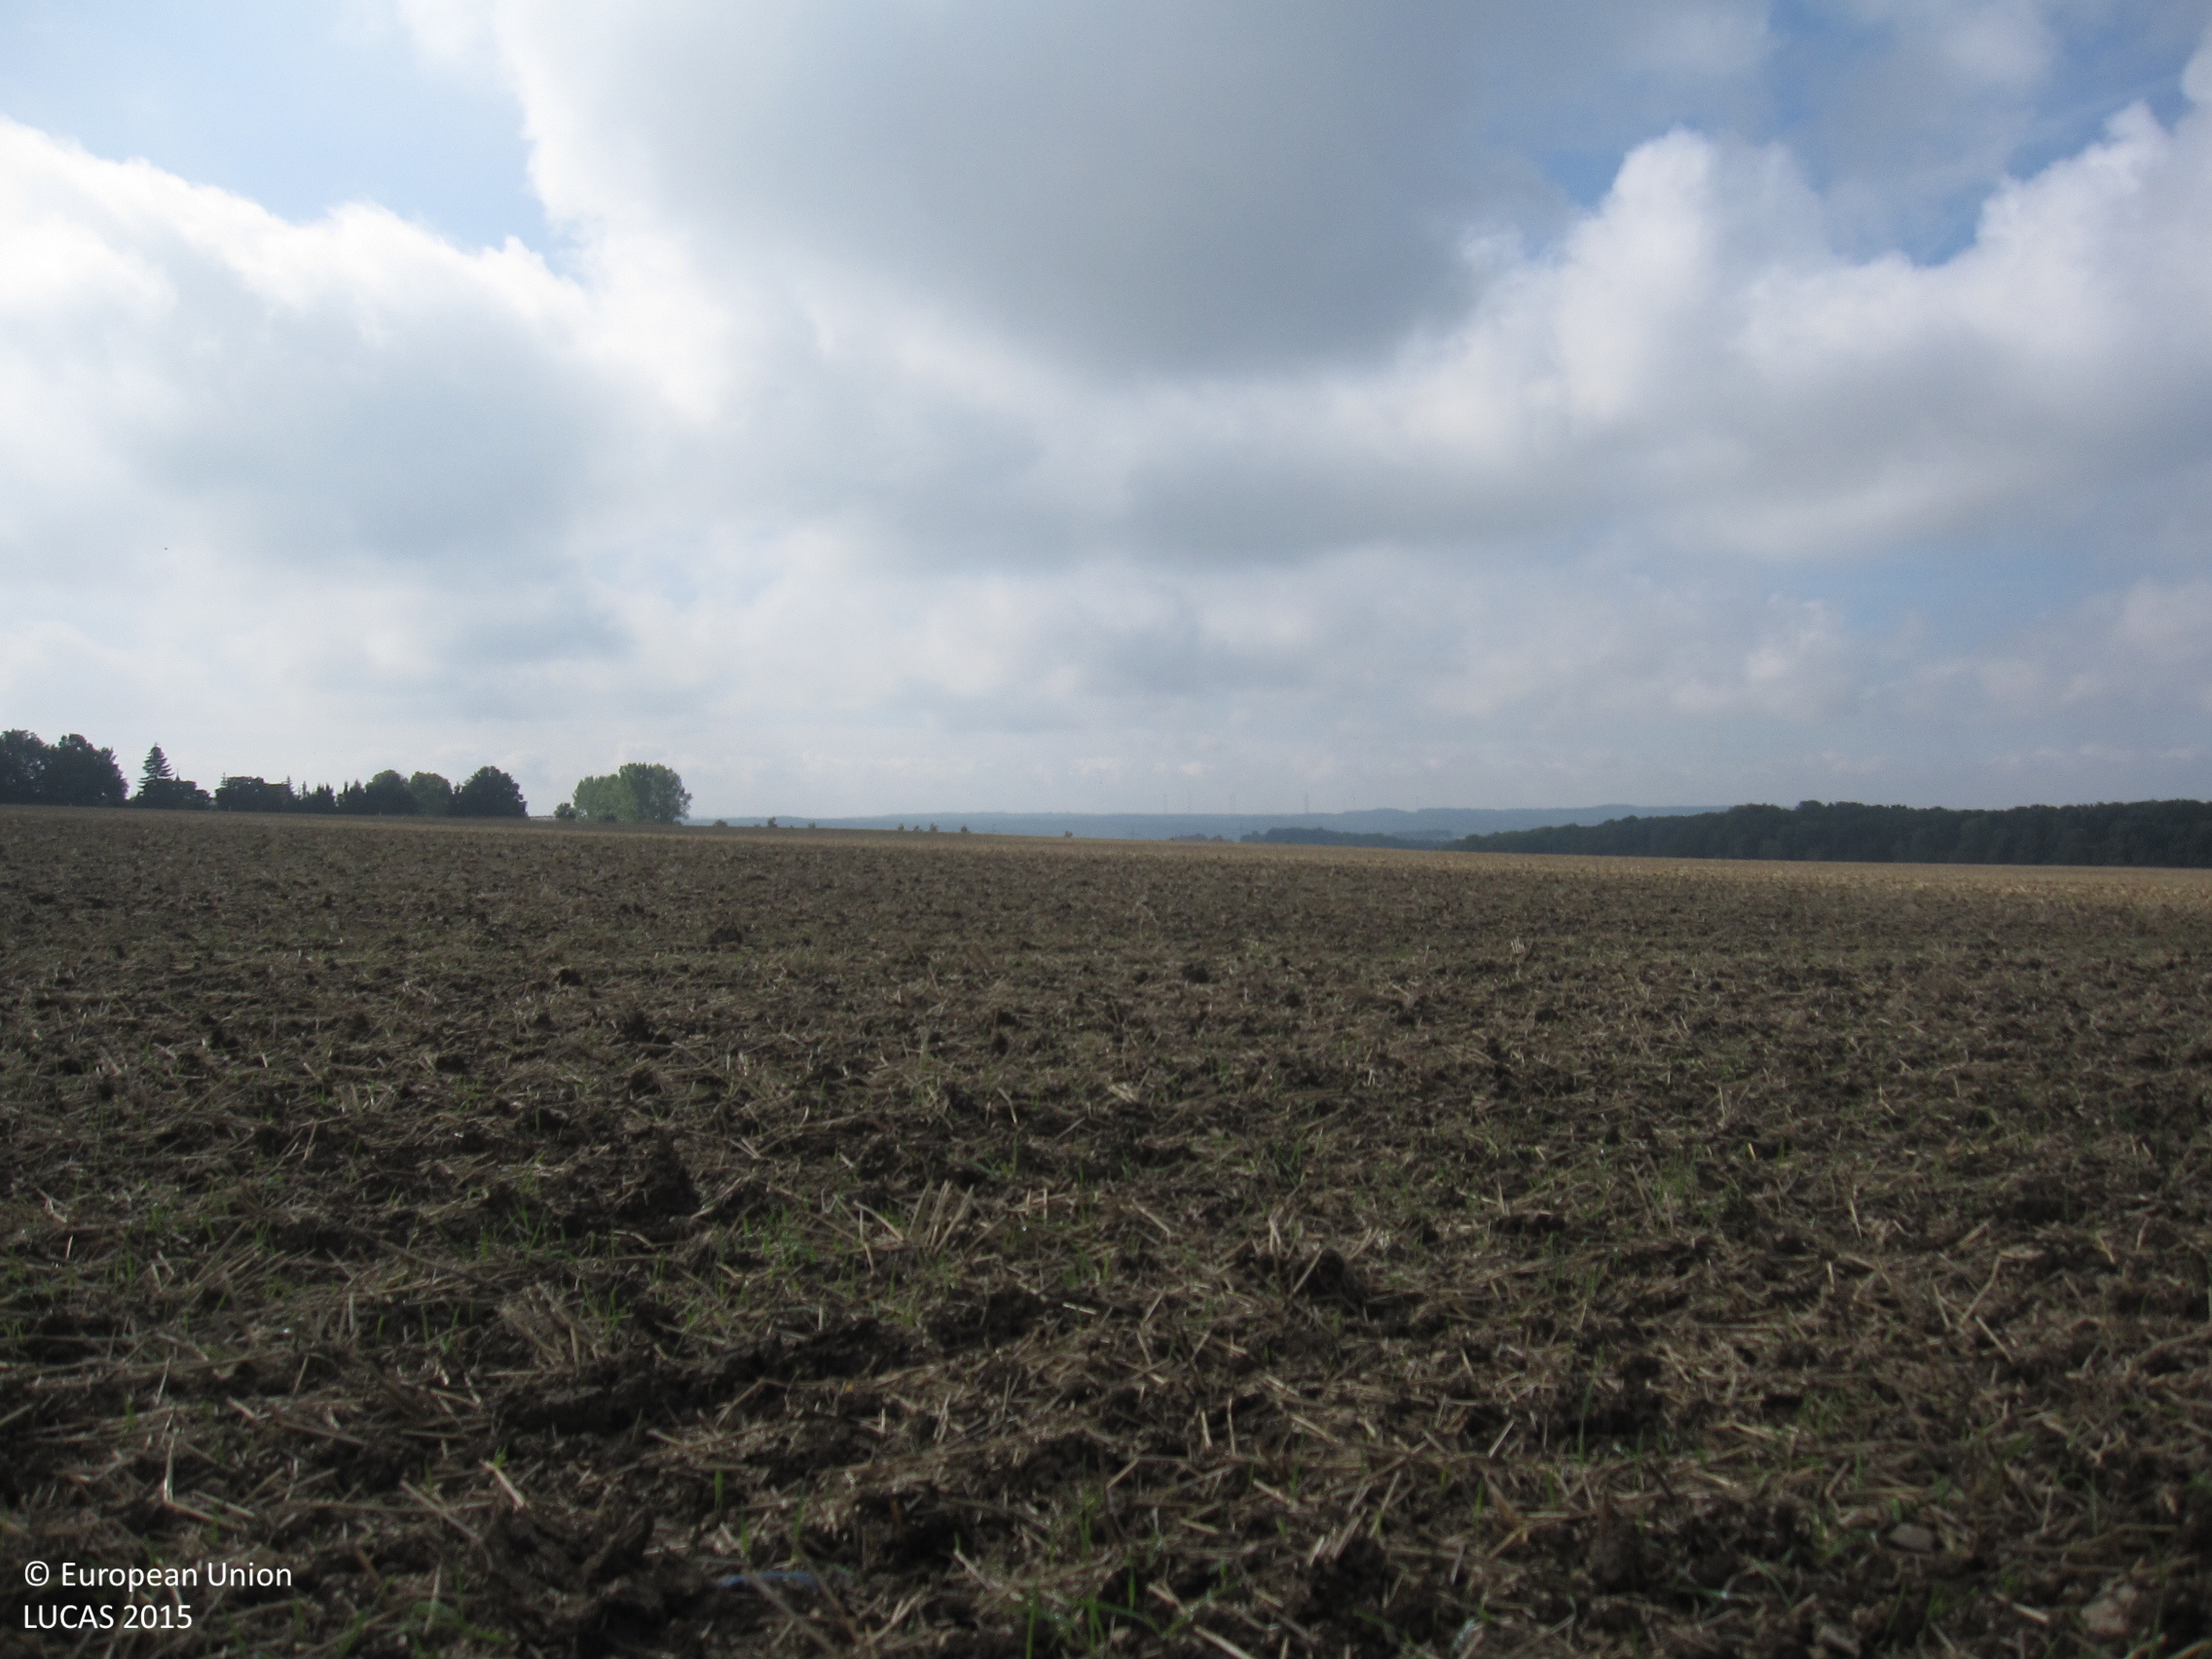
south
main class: Cropland
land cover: Common wheat
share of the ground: > 75 %
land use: Agriculture (excluding fallow land and kitchen gardens)
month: May
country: DE
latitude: 50.9650
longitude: 11.5517
